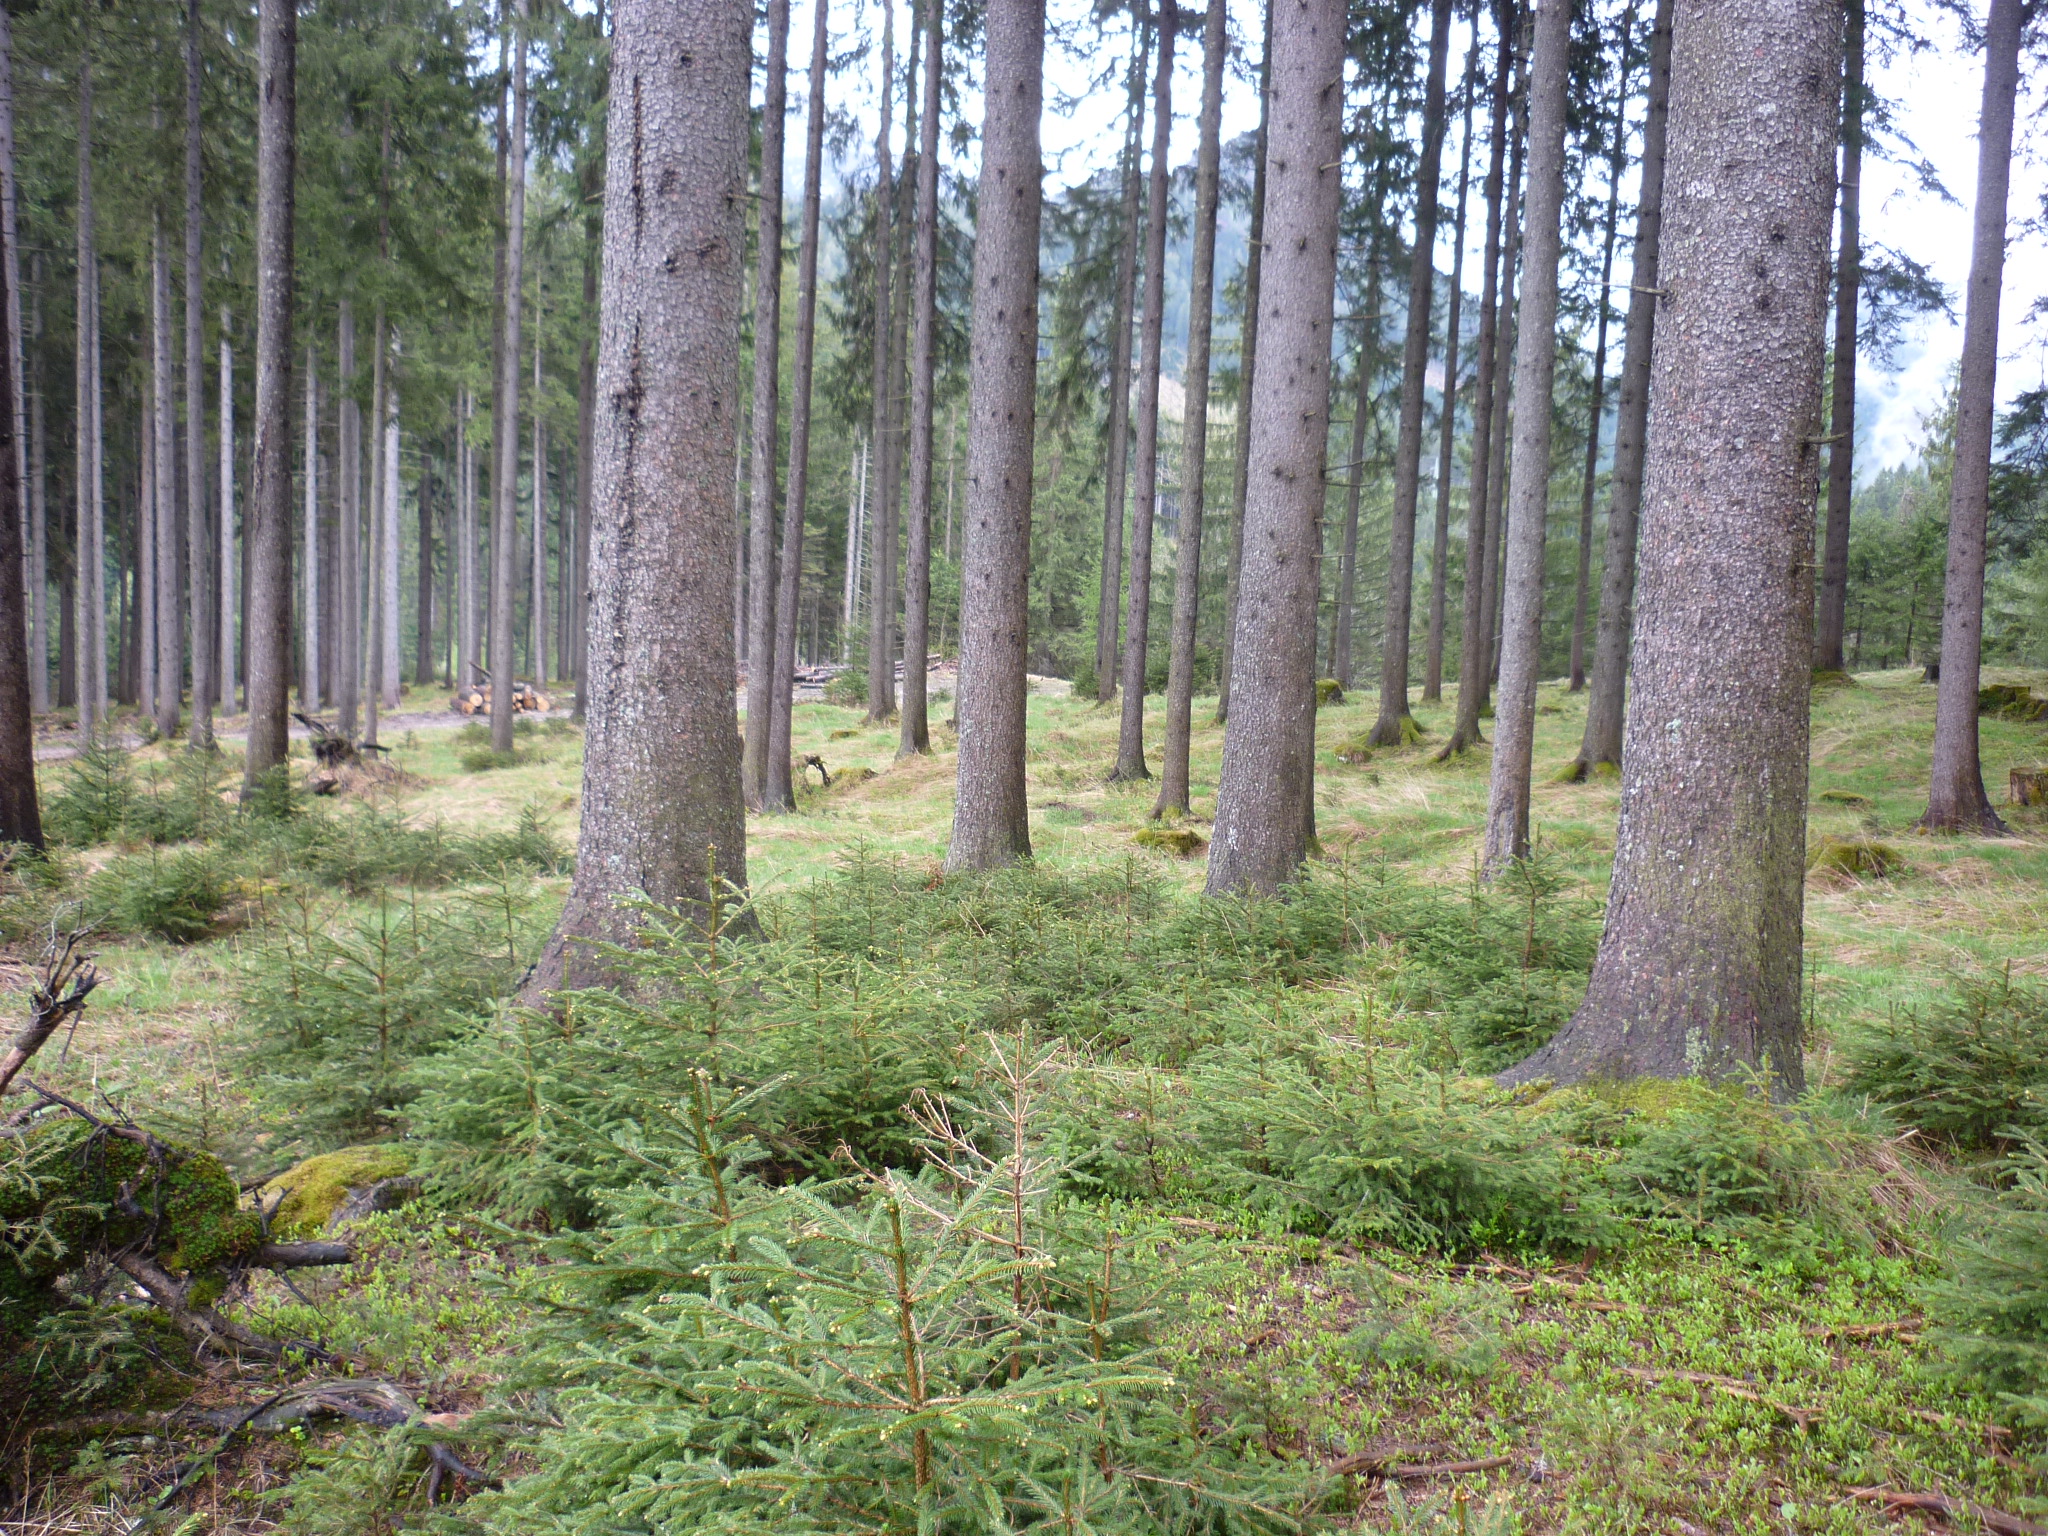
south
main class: Woodland
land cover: Spruce dominated coniferous woodland
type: alpine coniferous forest
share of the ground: 50 - 75 %
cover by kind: coniferous forest trees 70 %, herbaceous plants 20 %, lichens and mosses 10 %
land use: Forestry
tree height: > 5 m
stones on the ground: < 10 %
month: May
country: AT
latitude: 47.6424
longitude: 14.5652
